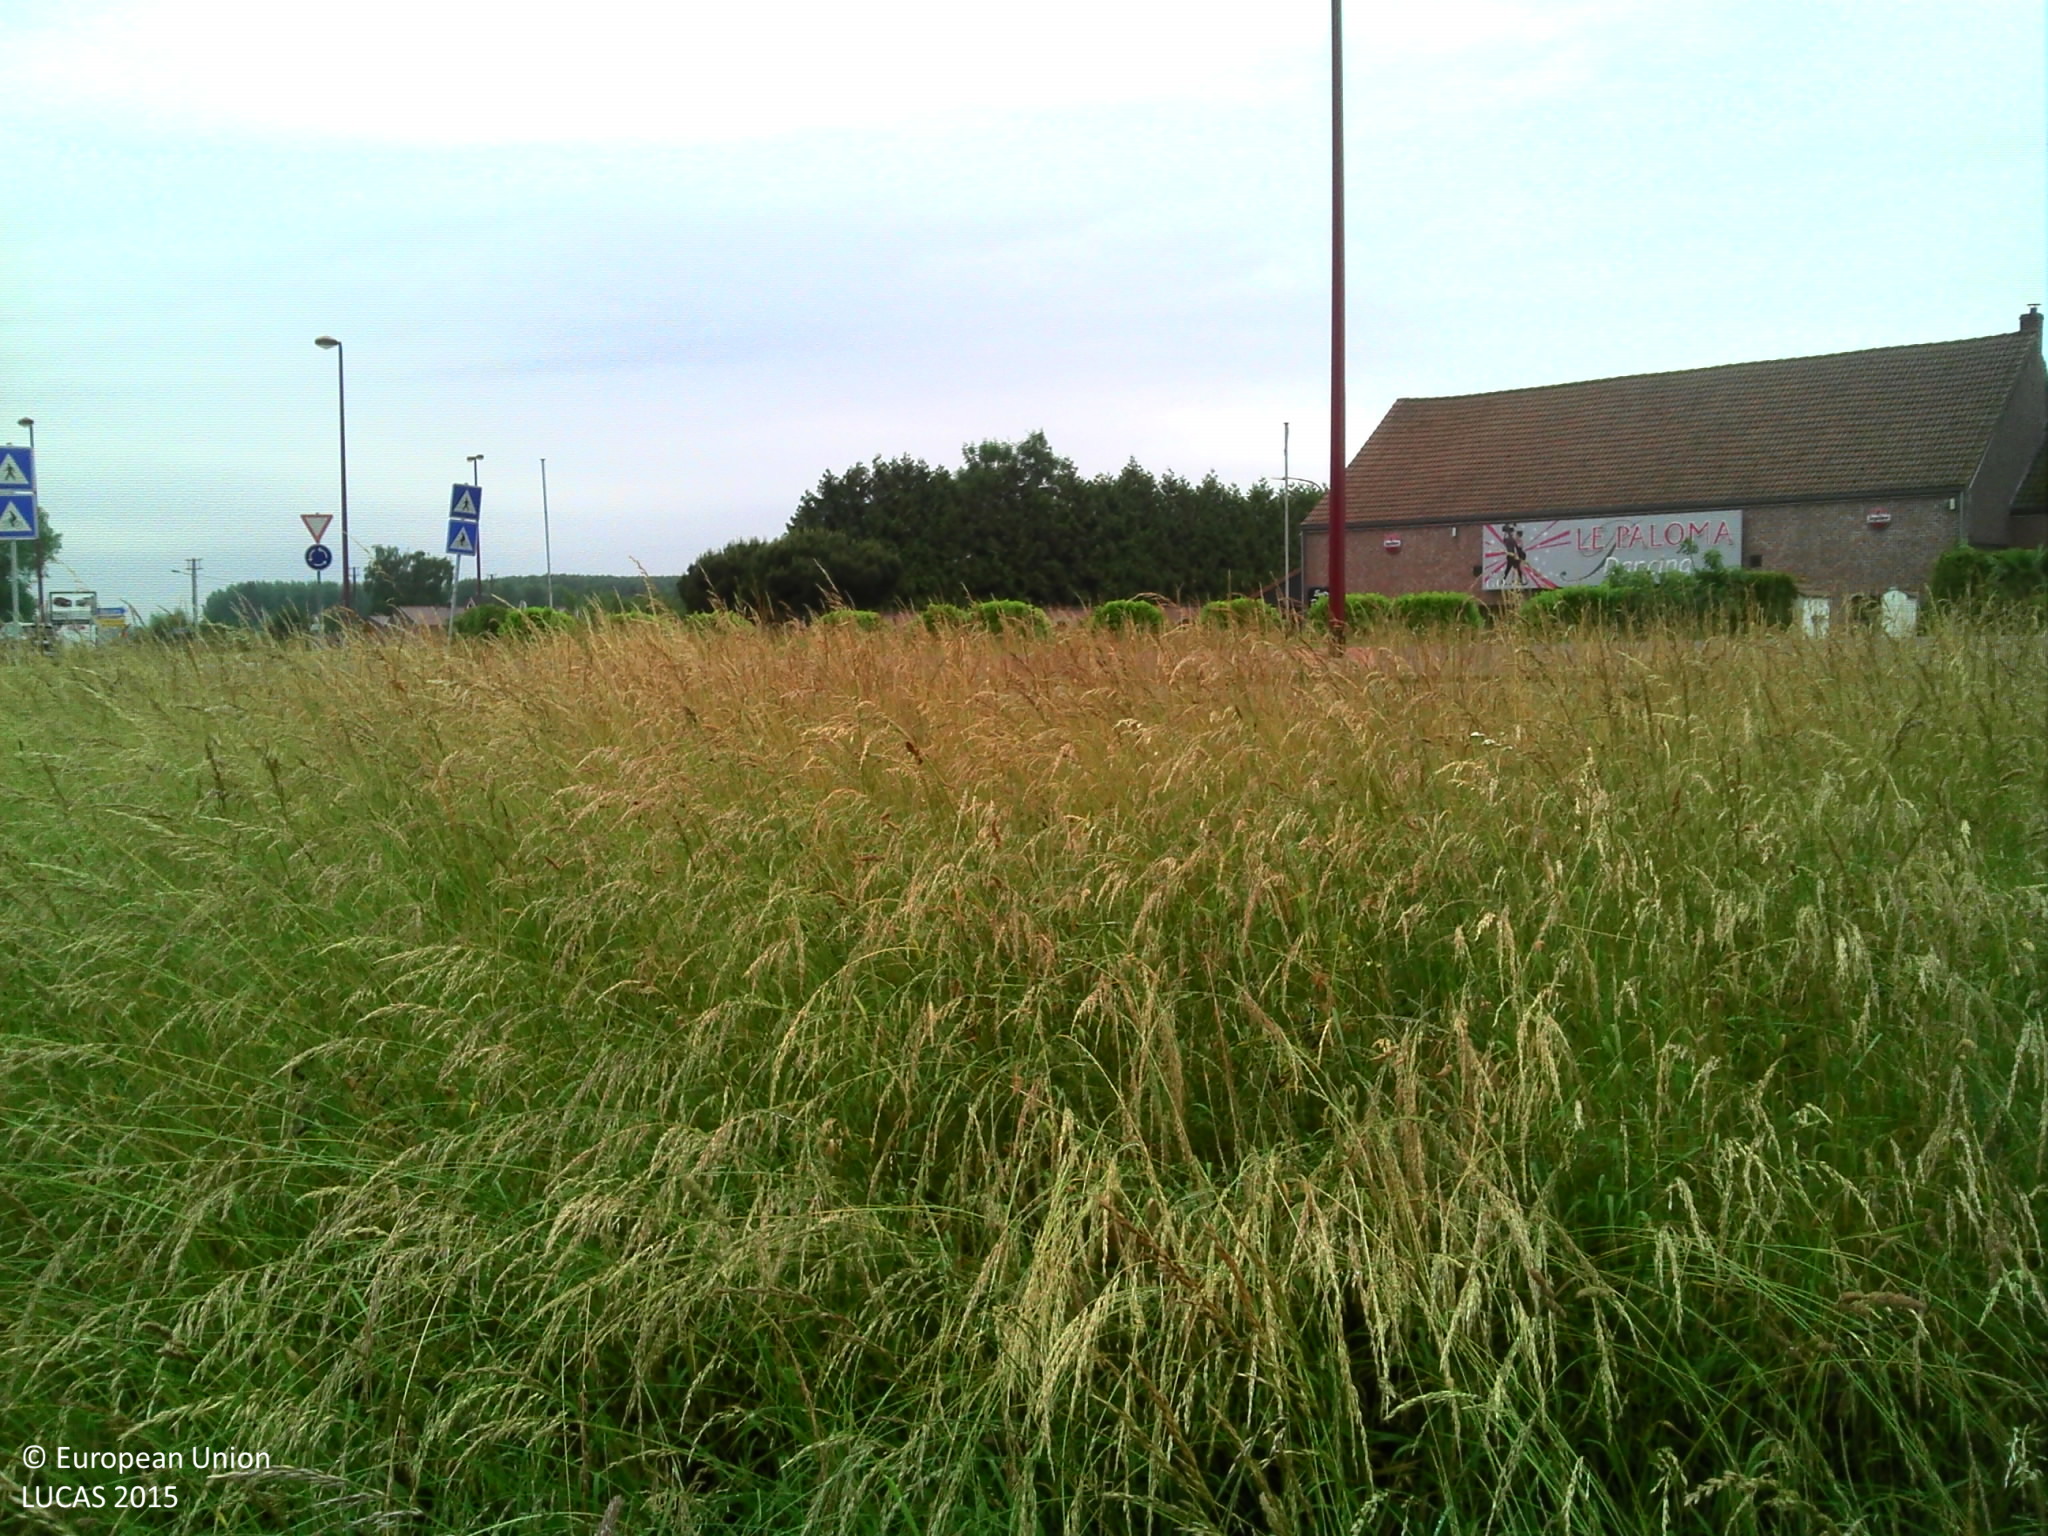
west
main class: Grassland
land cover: Grassland without tree/shrub cover
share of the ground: > 75 %
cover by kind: herbaceous plants 100 %
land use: Semi-natural and natural areas not in use
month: June
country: BE
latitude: 50.4265
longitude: 3.7292
